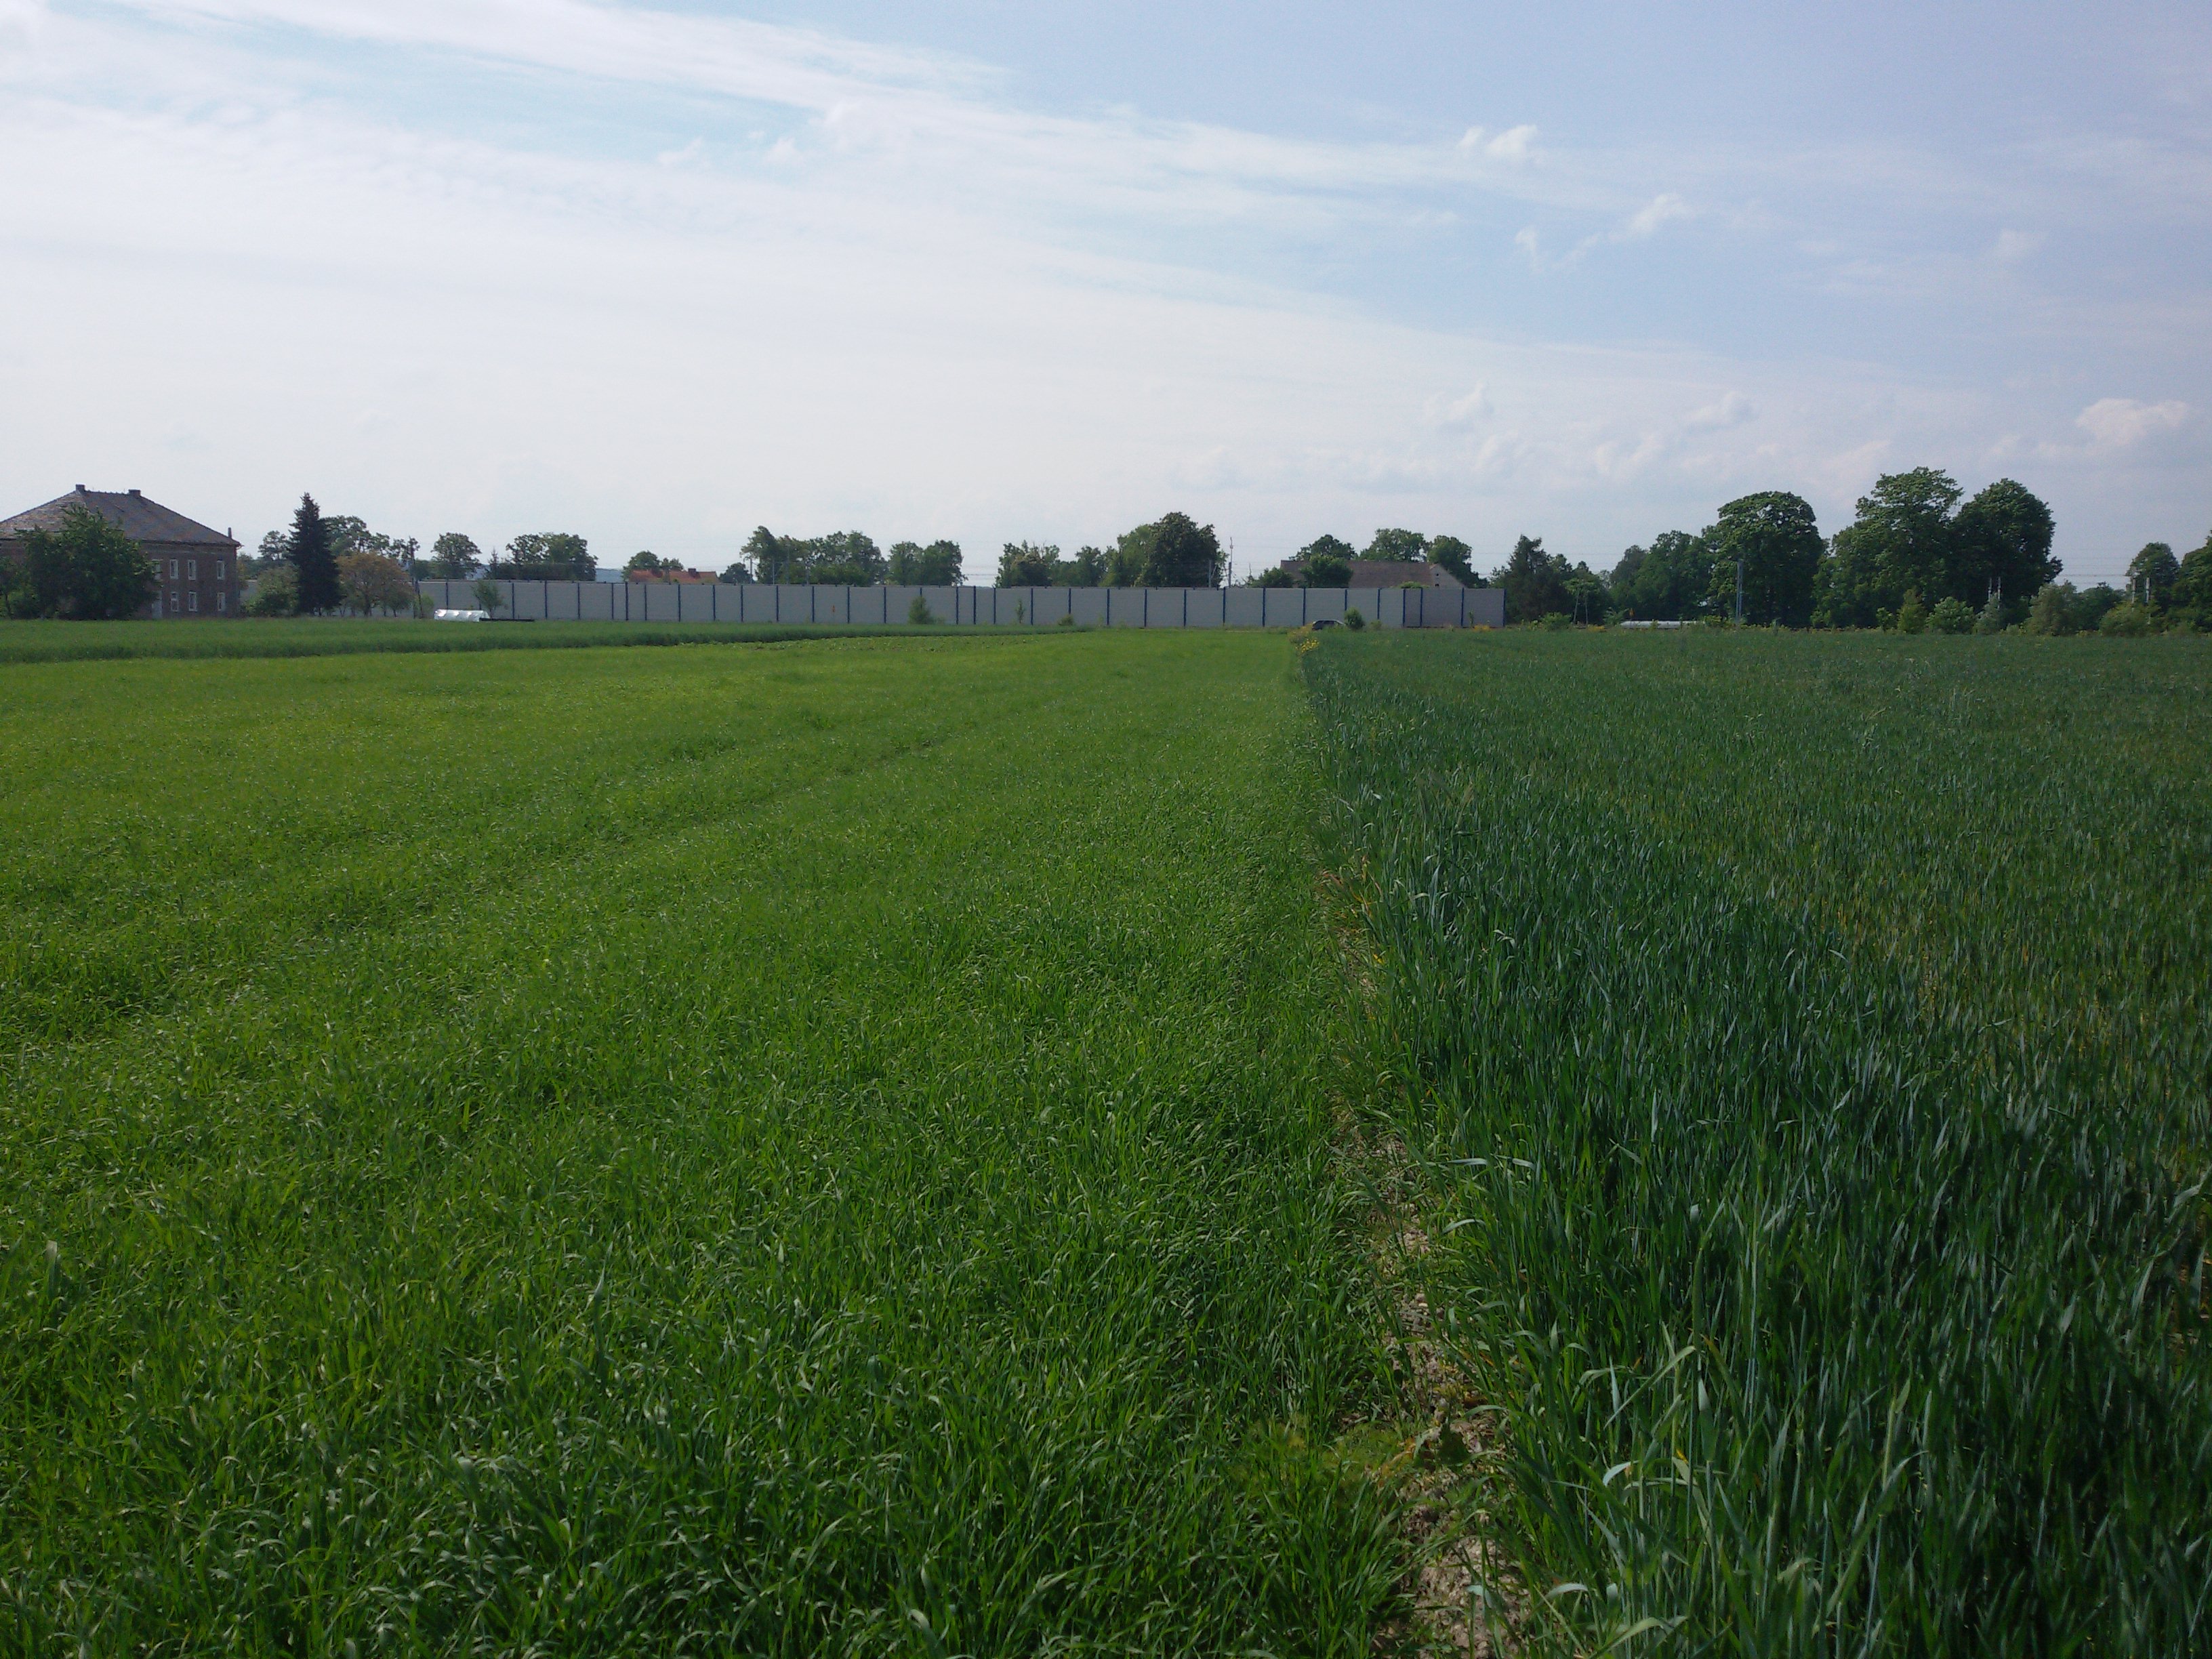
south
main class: Cropland
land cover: Barley
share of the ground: > 75 %
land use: Agriculture (excluding fallow land and kitchen gardens)
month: May
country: PL
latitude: 51.2842
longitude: 15.7257
